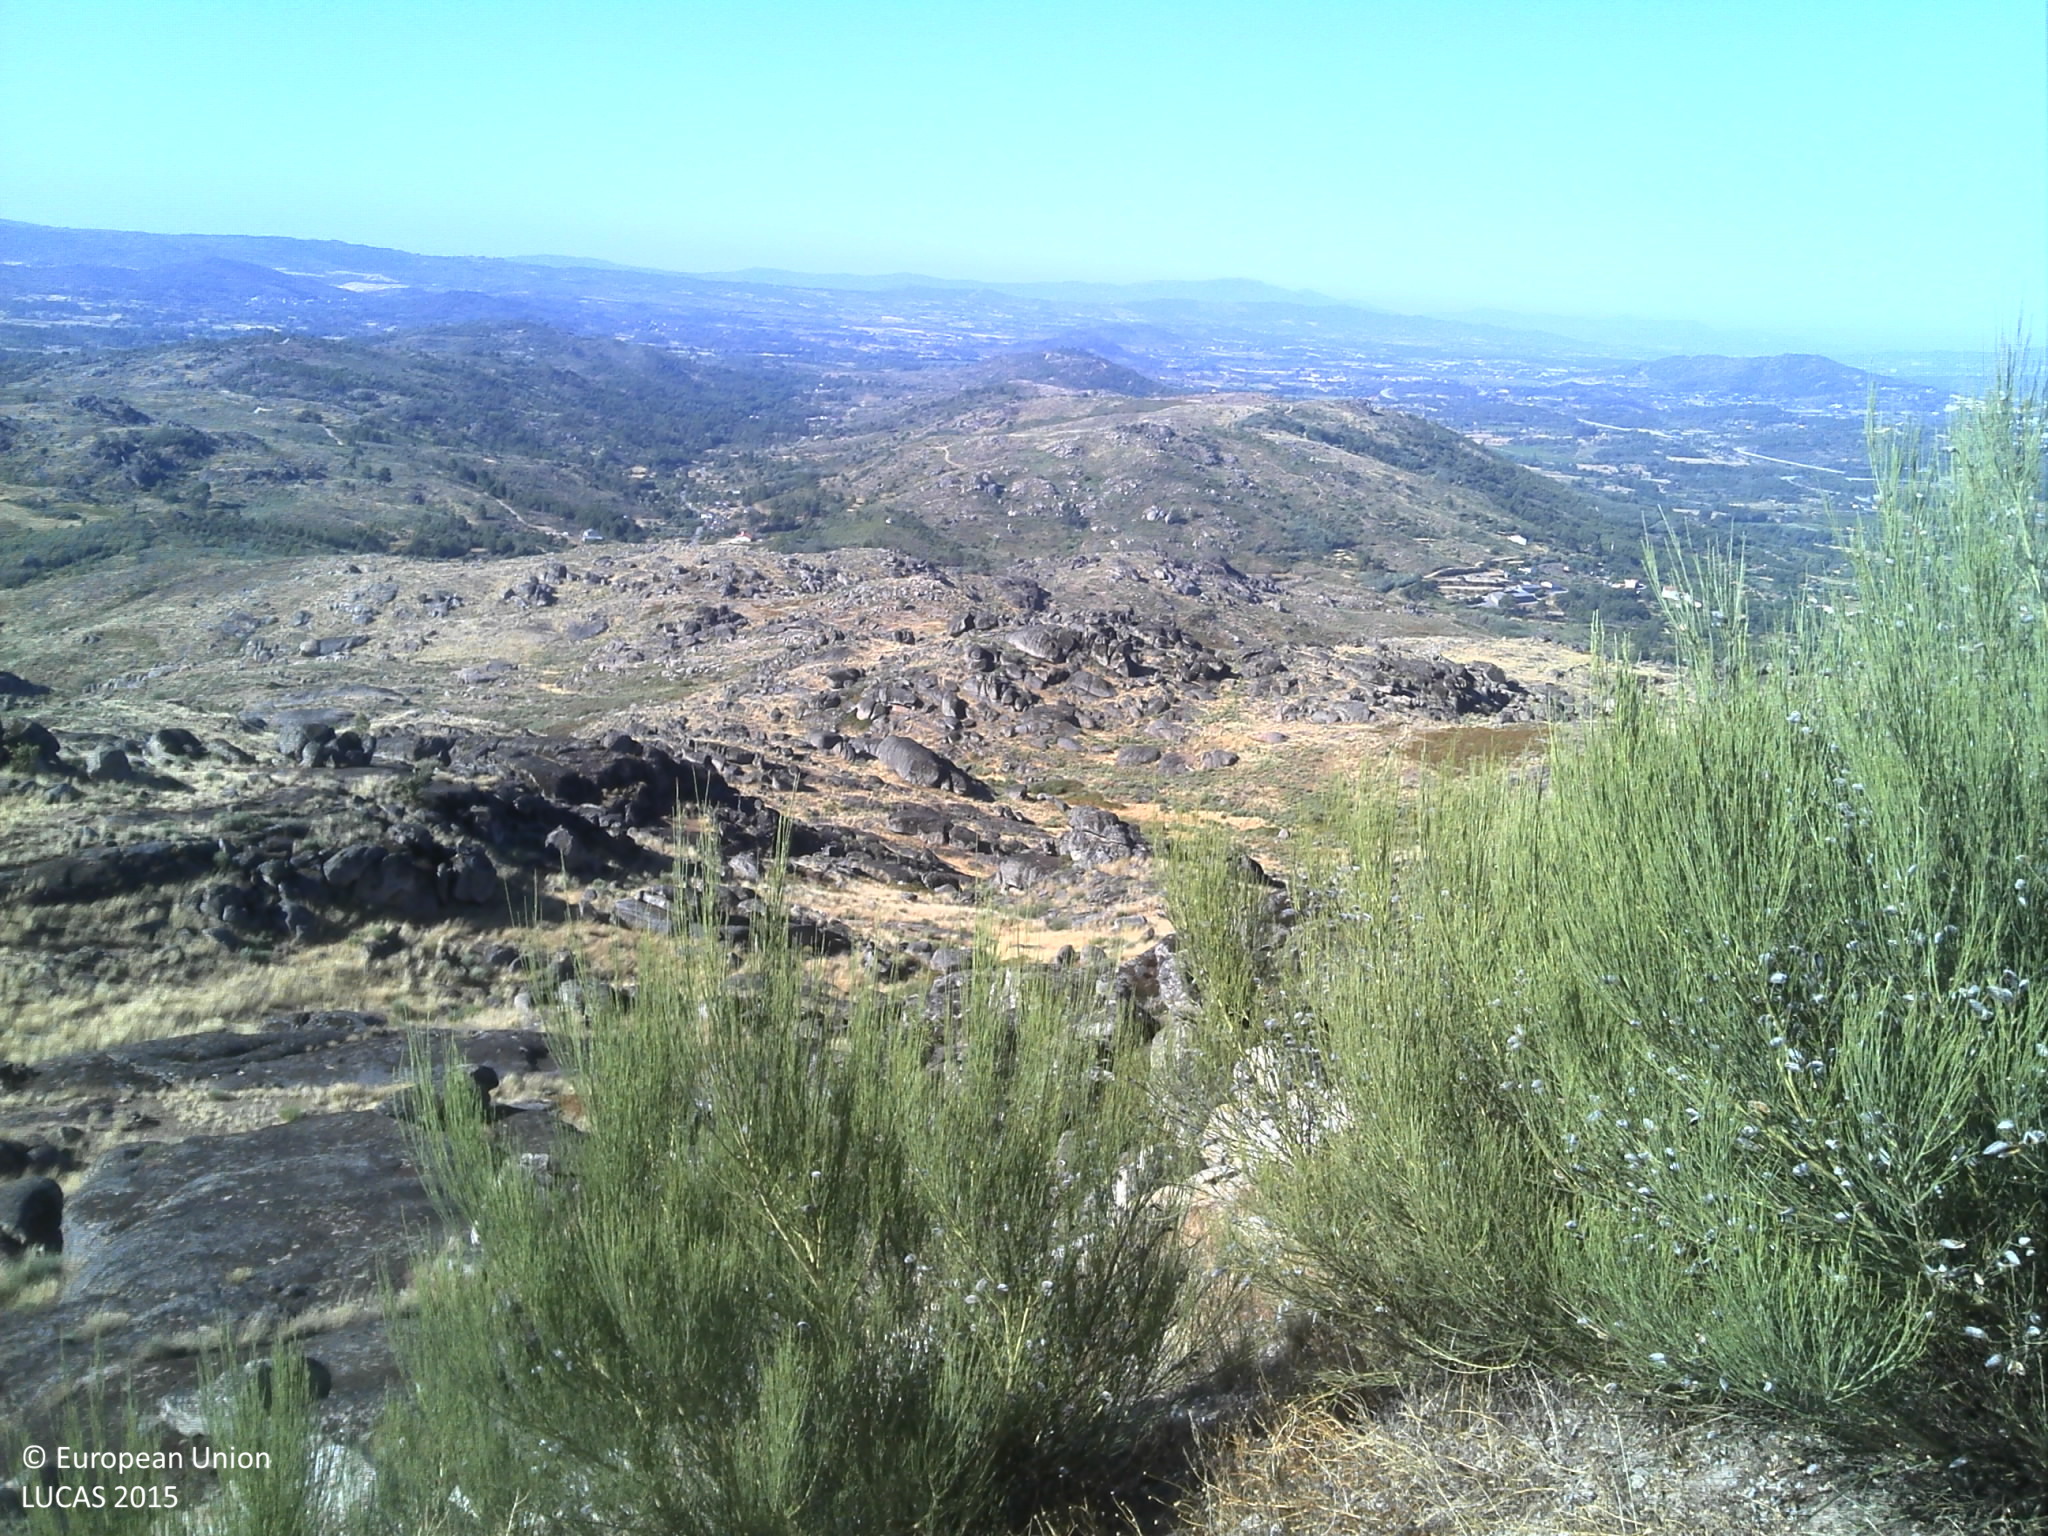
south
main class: Shrubland
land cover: Shrubland without tree cover
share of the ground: 50 - 75 %
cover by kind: shrubs 60 %, unconsolidated bare surface 20 %, herbaceous plants 10 %
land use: Semi-natural and natural areas not in use
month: July
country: PT
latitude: 40.4013
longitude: -7.2708
